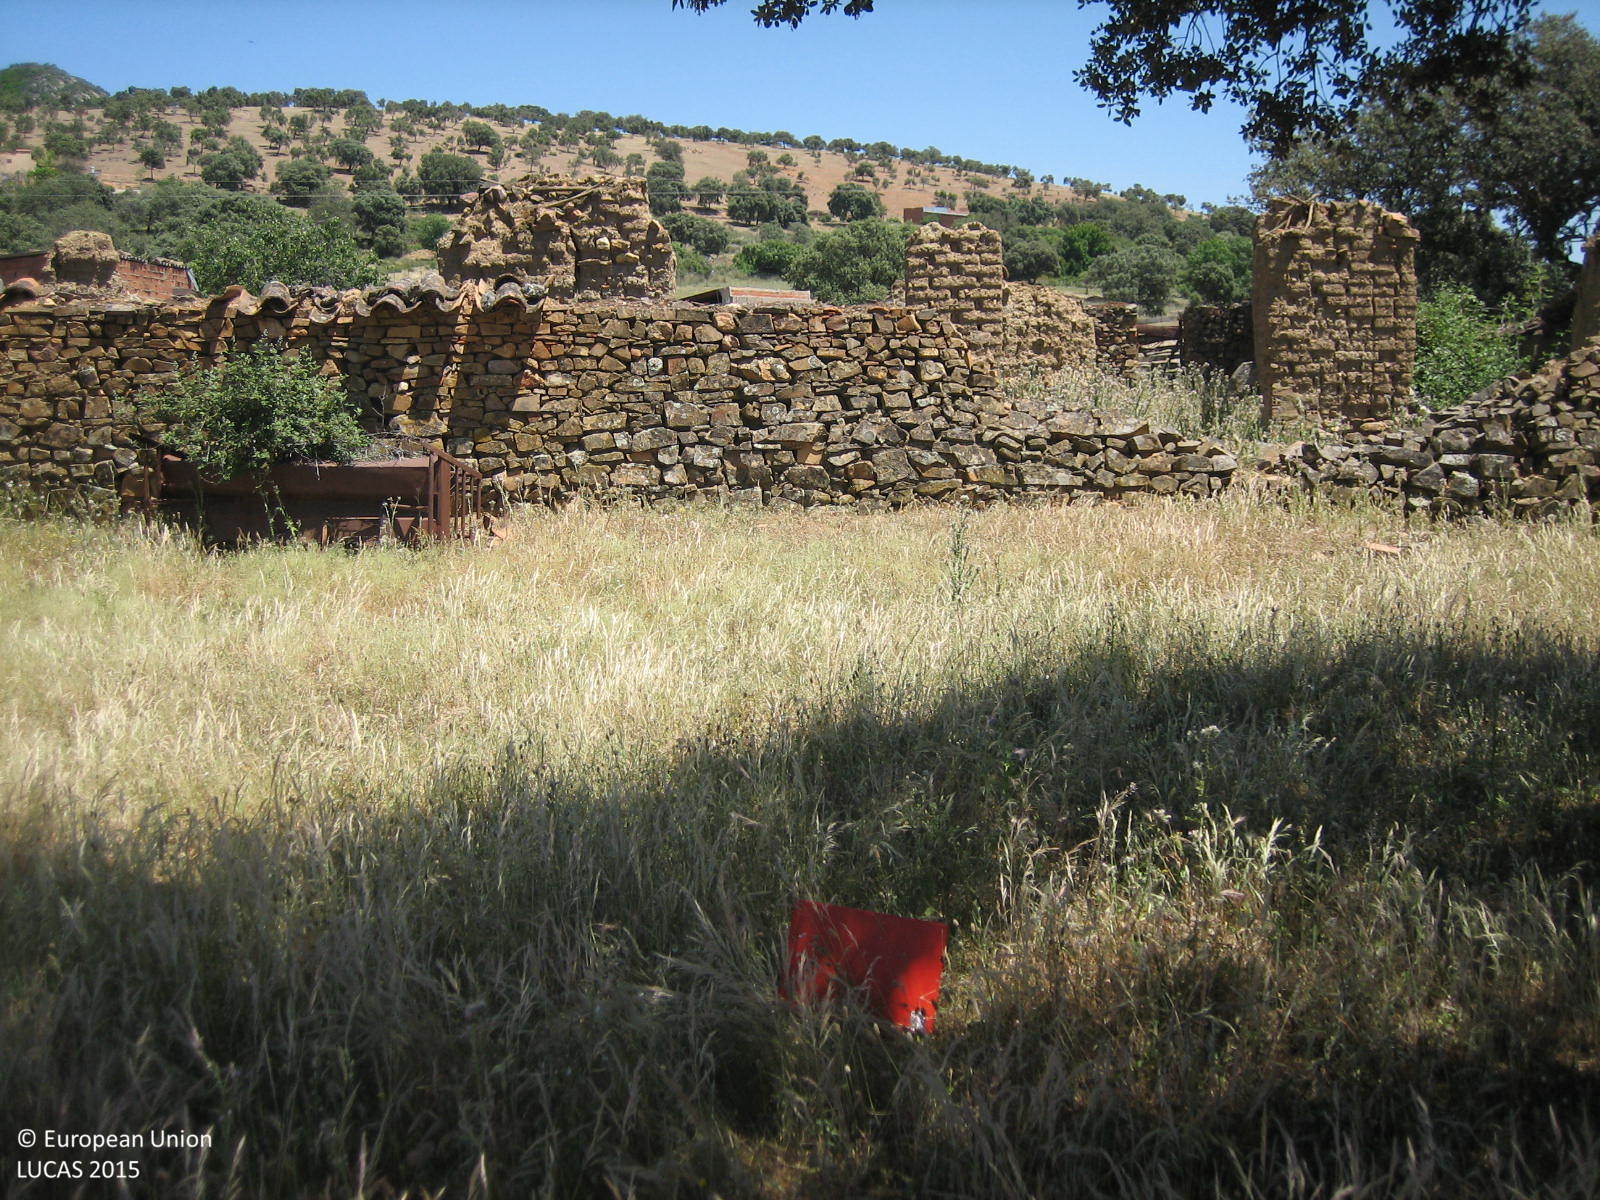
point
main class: Grassland
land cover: Grassland with sparse tree/shrub cover
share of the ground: > 75 %
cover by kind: herbaceous plants 75 %, broadleaved forest trees 5 %
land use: Agriculture (excluding fallow land and kitchen gardens)
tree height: > 5 m
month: May
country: ES
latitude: 39.0977
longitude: -4.9405
